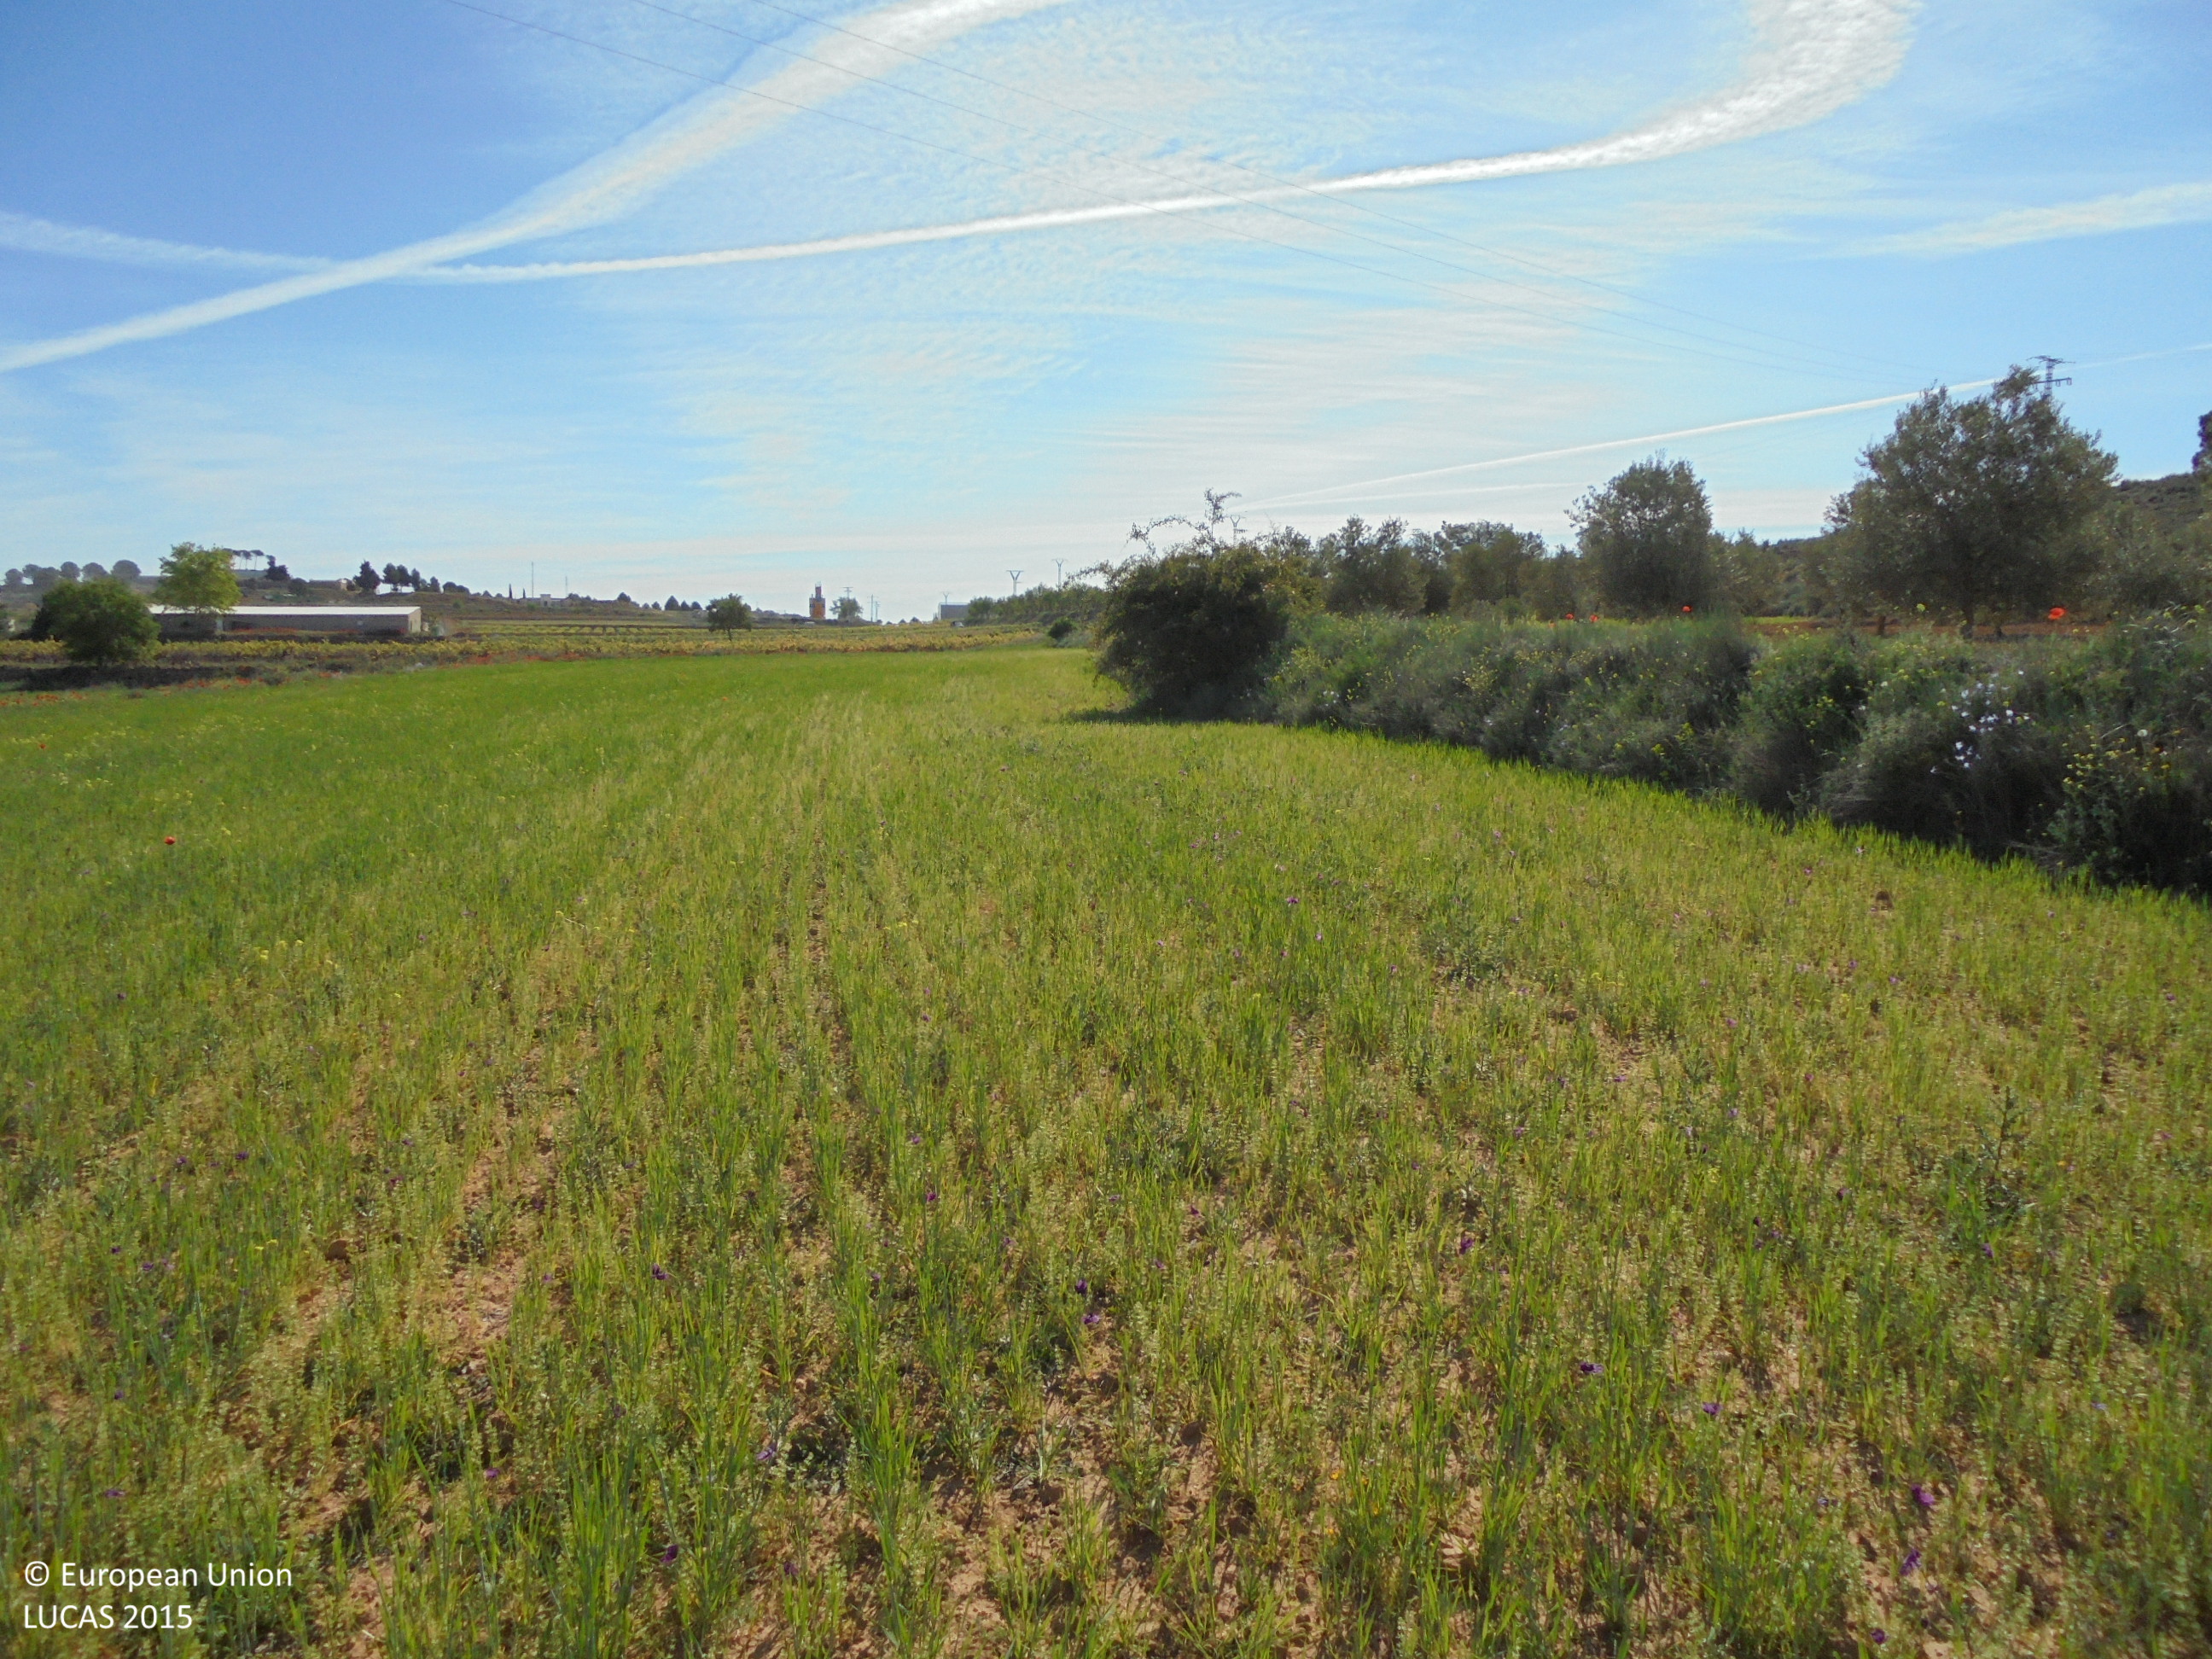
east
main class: Cropland
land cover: Barley
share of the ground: 25 - 50 %
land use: Agriculture (excluding fallow land and kitchen gardens)
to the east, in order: Barley; Single bushes/trees; Grass margins; Olive groves; Electric lines; Grass margins; Dry stone walls; Grass margins; Barley; Grassland without tree/shrub cover; Single bushes/trees; Grass margins; Vineyards; Grassland without tree/shrub cover; Dry stone walls; Grassland without tree/shrub cover; Nuts trees; Grassland without tree/shrub cover; Rock outcrops; Grassland without tree/shrub cover; Nuts trees
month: May
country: ES
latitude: 39.2713
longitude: -1.5580
